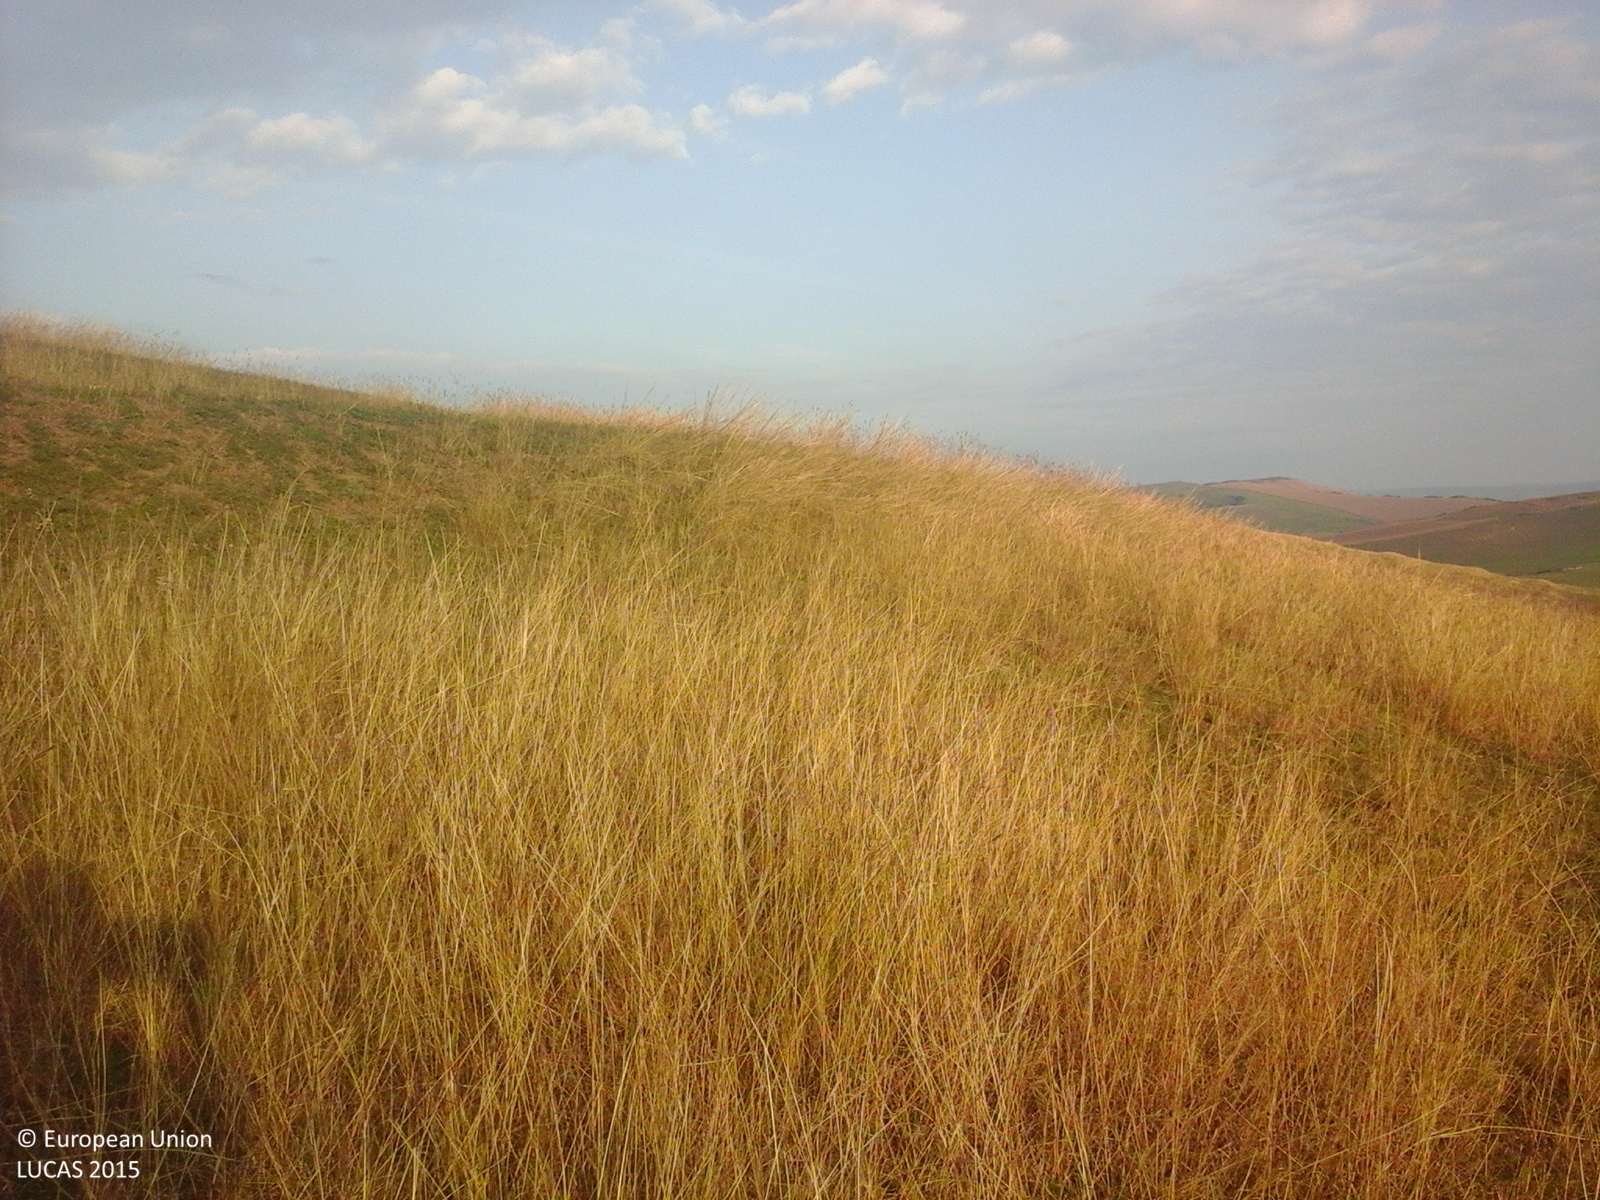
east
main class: Grassland
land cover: Grassland without tree/shrub cover
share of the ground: > 75 %
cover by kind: herbaceous plants 100 %
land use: Agriculture (excluding fallow land and kitchen gardens)
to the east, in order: Grassland without tree/shrub cover
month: October
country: RO
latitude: 46.4876
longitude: 23.9765
